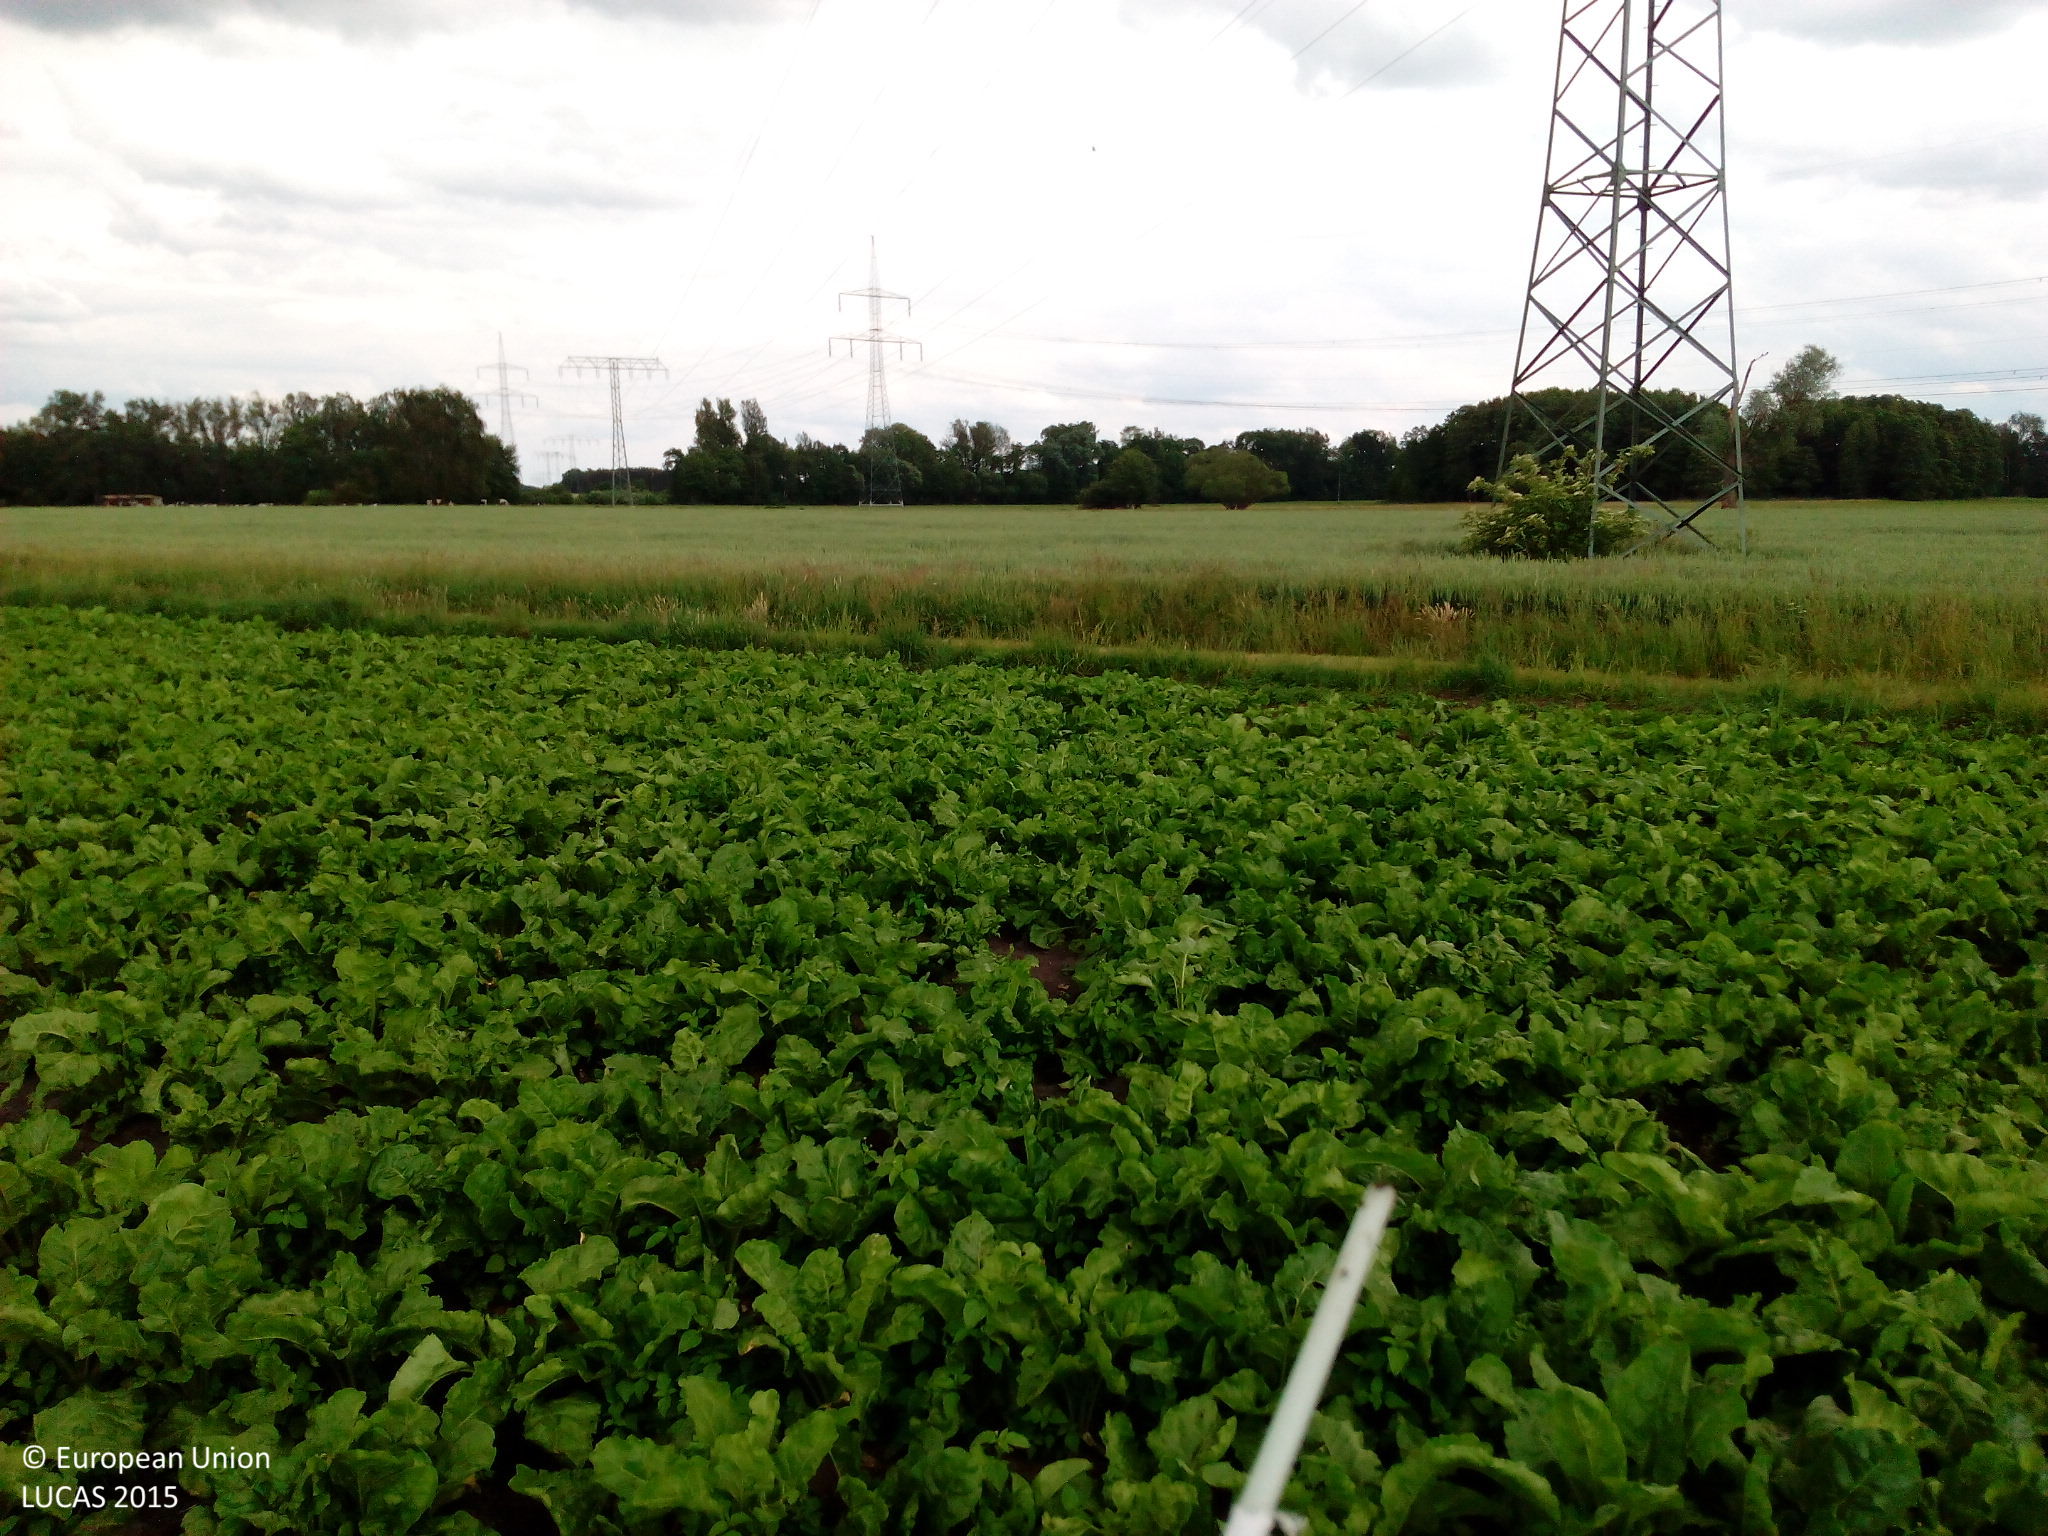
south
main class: Cropland
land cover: Triticale
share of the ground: > 75 %
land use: Agriculture (excluding fallow land and kitchen gardens)
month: June
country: DE
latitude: 52.5138
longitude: 12.4604
